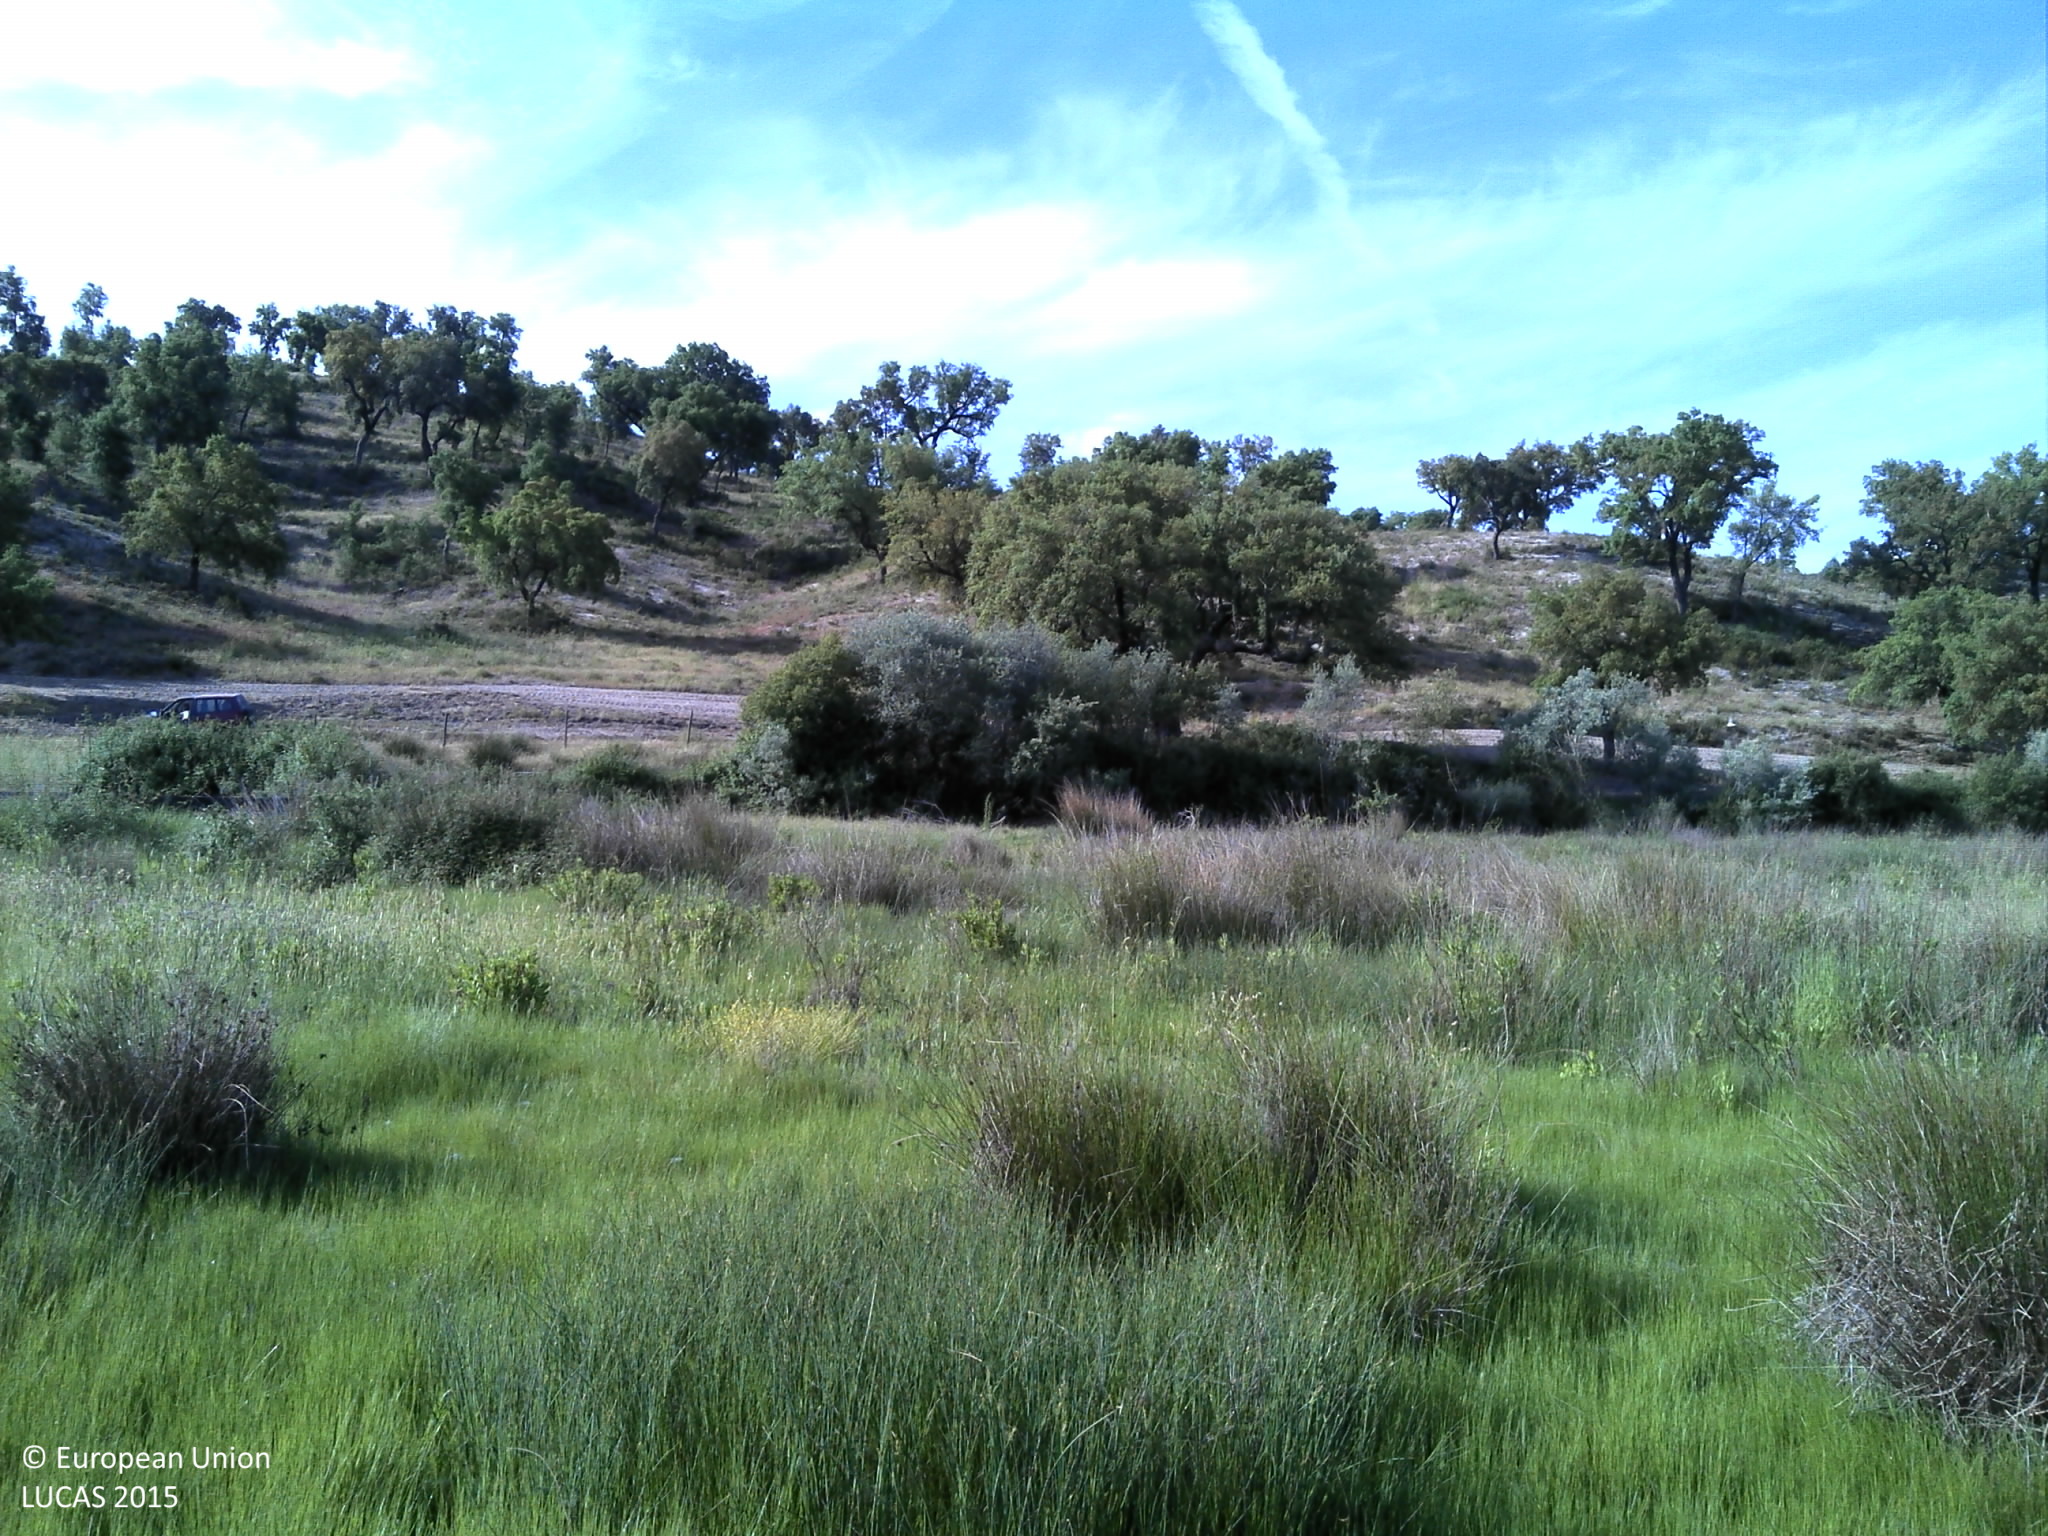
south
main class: Grassland
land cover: Grassland without tree/shrub cover
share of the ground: > 75 %
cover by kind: herbaceous plants 80 %, unconsolidated bare surface 20 %
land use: Agriculture (excluding fallow land and kitchen gardens)
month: May
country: PT
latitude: 39.3079
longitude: -7.9011
